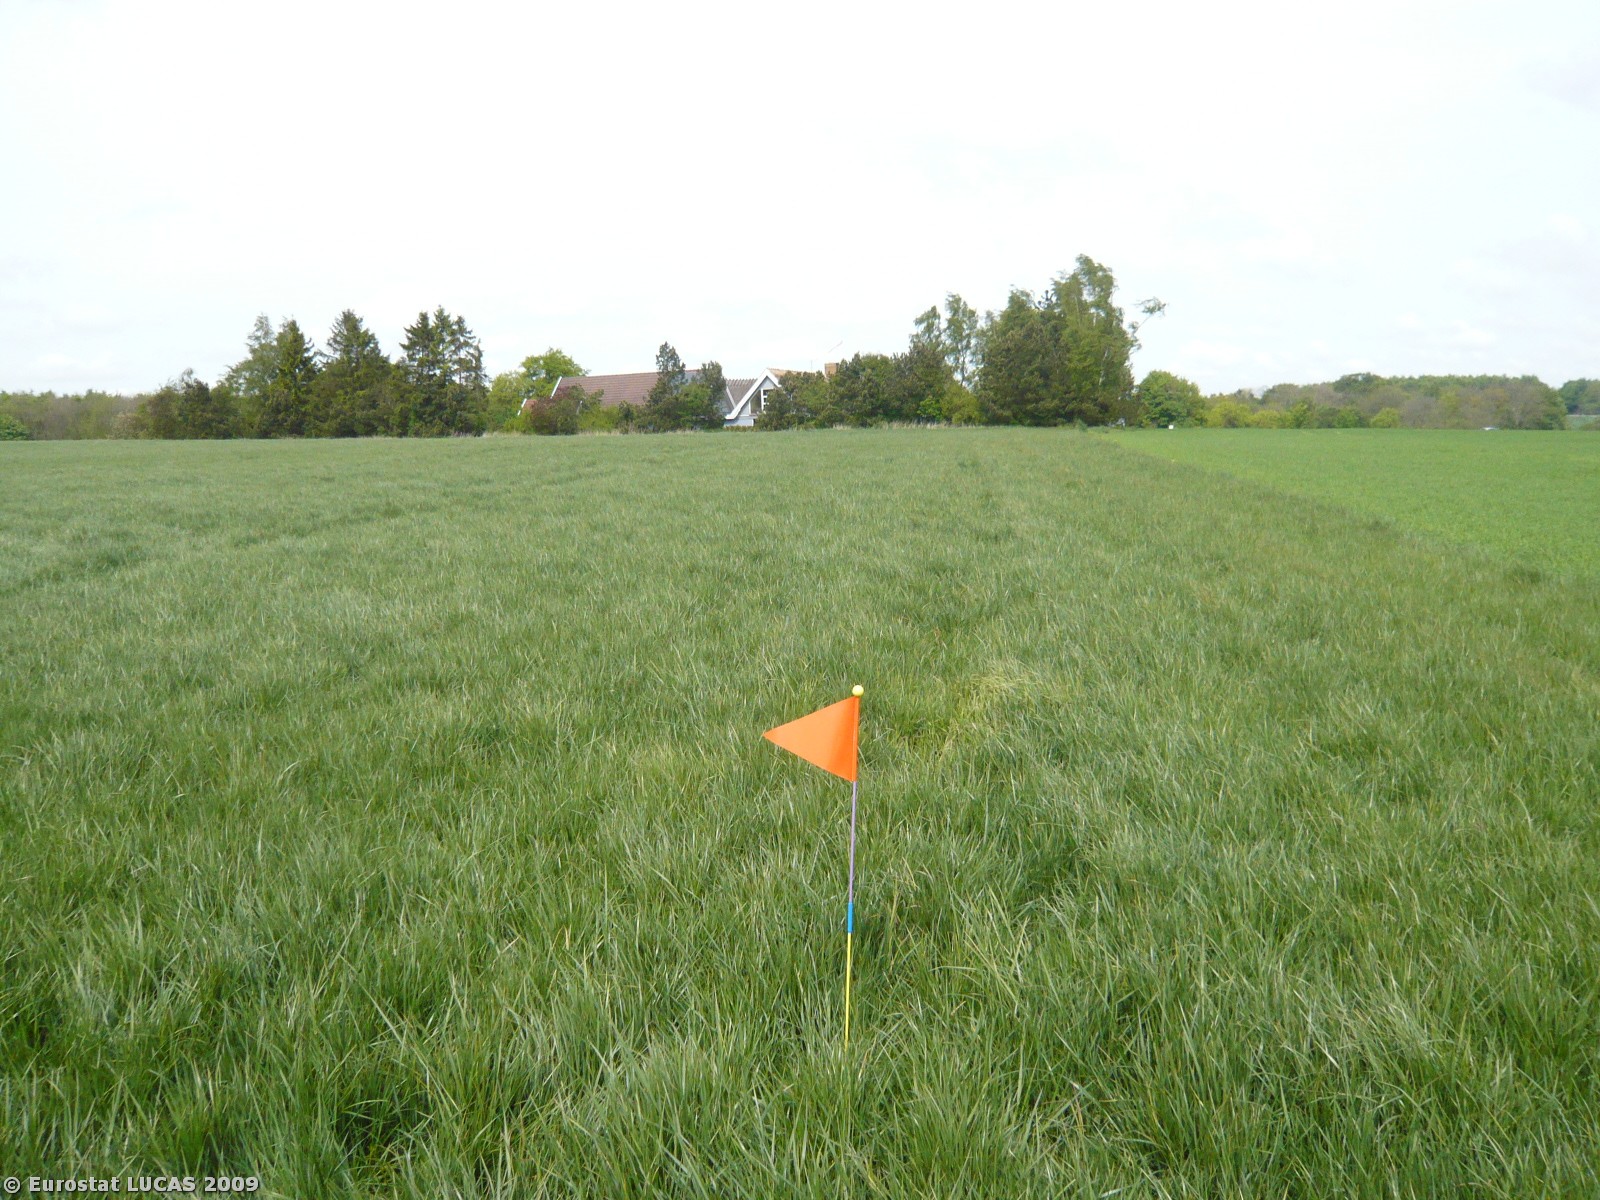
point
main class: Grassland
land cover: Grassland without tree/shrub cover
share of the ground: > 75 %
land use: Agriculture (excluding fallow land and kitchen gardens)
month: May
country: DK
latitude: 55.2537
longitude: 12.0909
